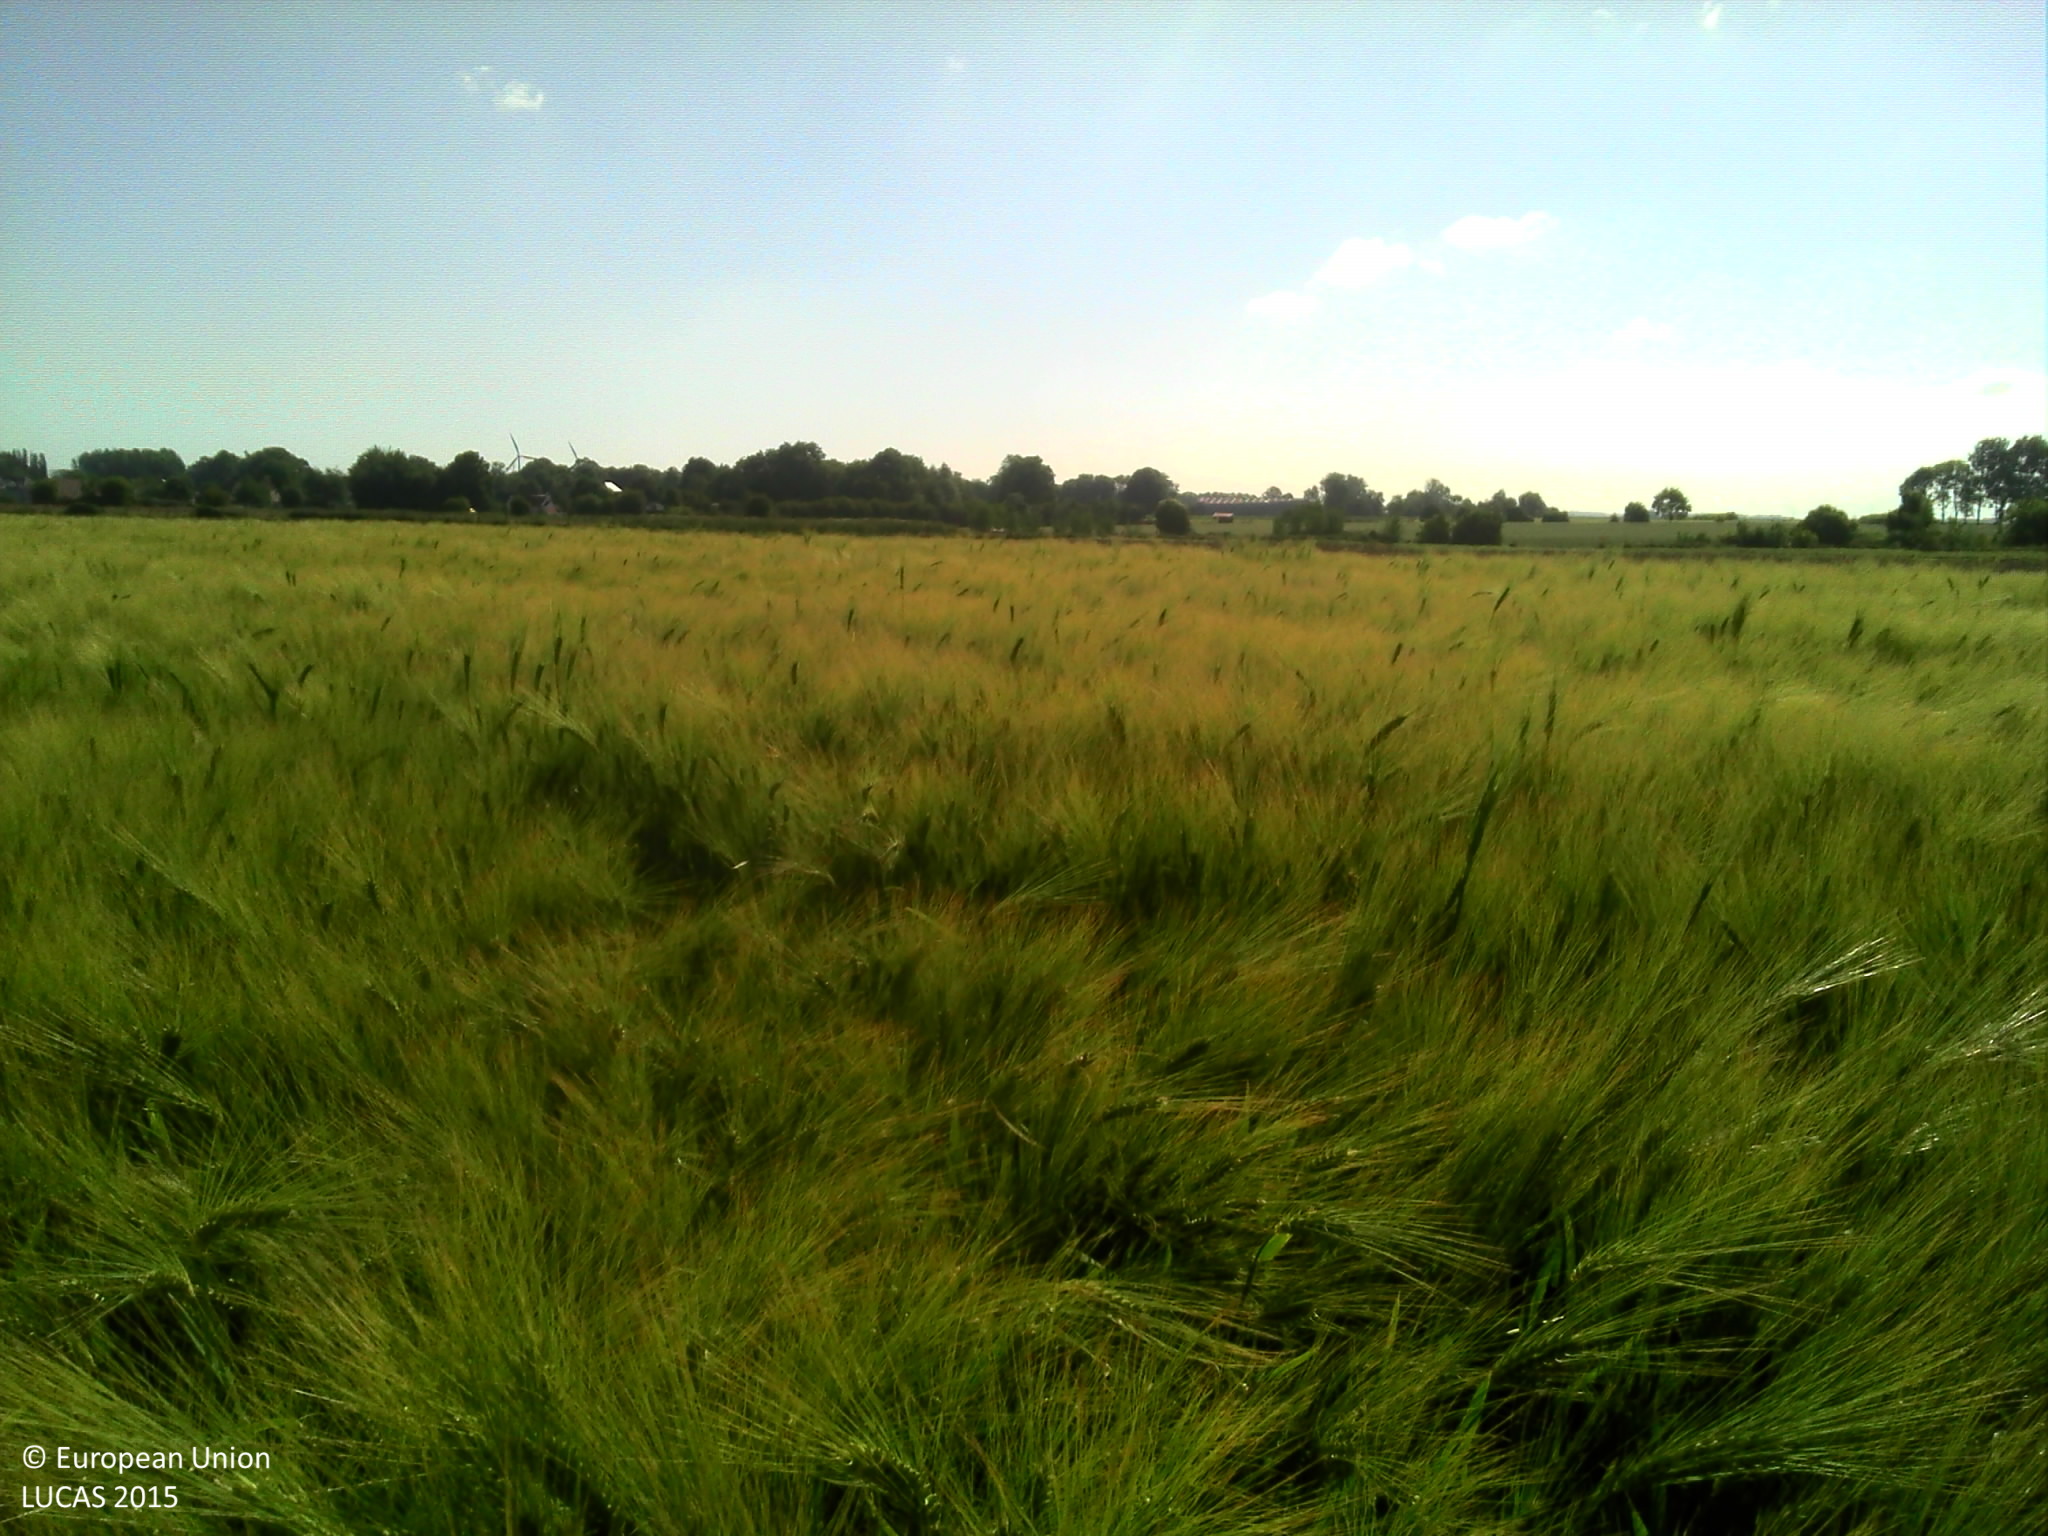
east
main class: Cropland
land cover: Barley
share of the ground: > 75 %
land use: Agriculture (excluding fallow land and kitchen gardens)
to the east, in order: Barley; Grass margins; Other bare soil; Spontaneously vegetated surfaces; Abandoned hedges; Tracks
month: June
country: FR
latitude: 50.0538
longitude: 1.5877
